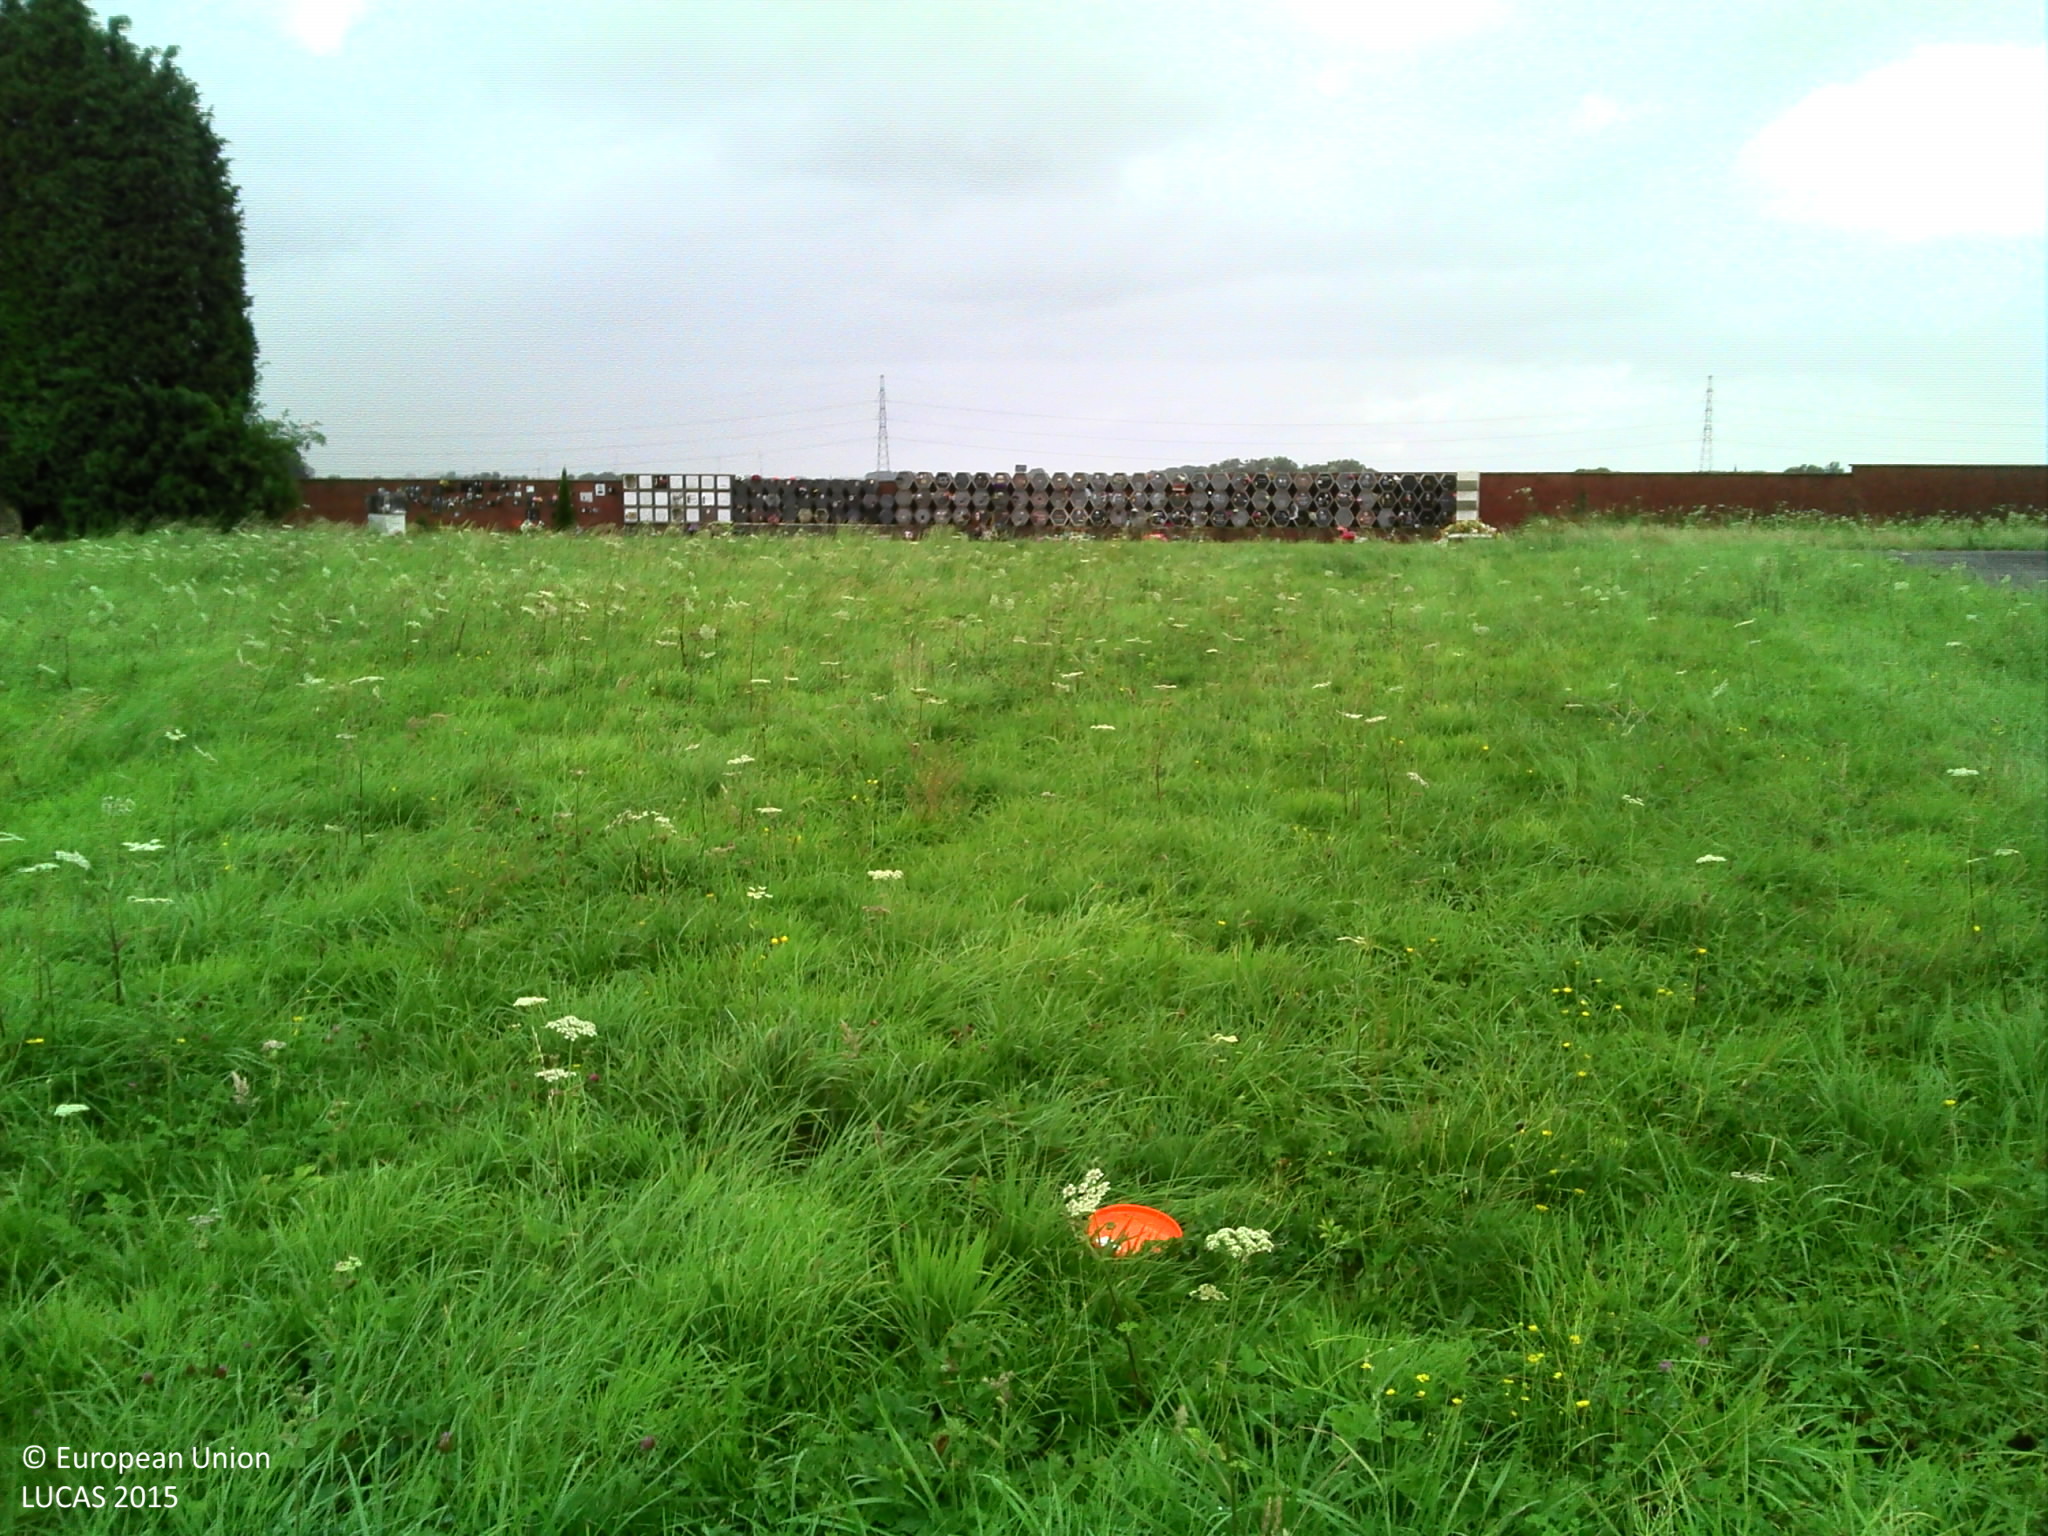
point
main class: Grassland
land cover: Grassland without tree/shrub cover
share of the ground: > 75 %
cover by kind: herbaceous plants 100 %
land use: Community services
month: July
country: BE
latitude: 50.4861
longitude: 4.5415
